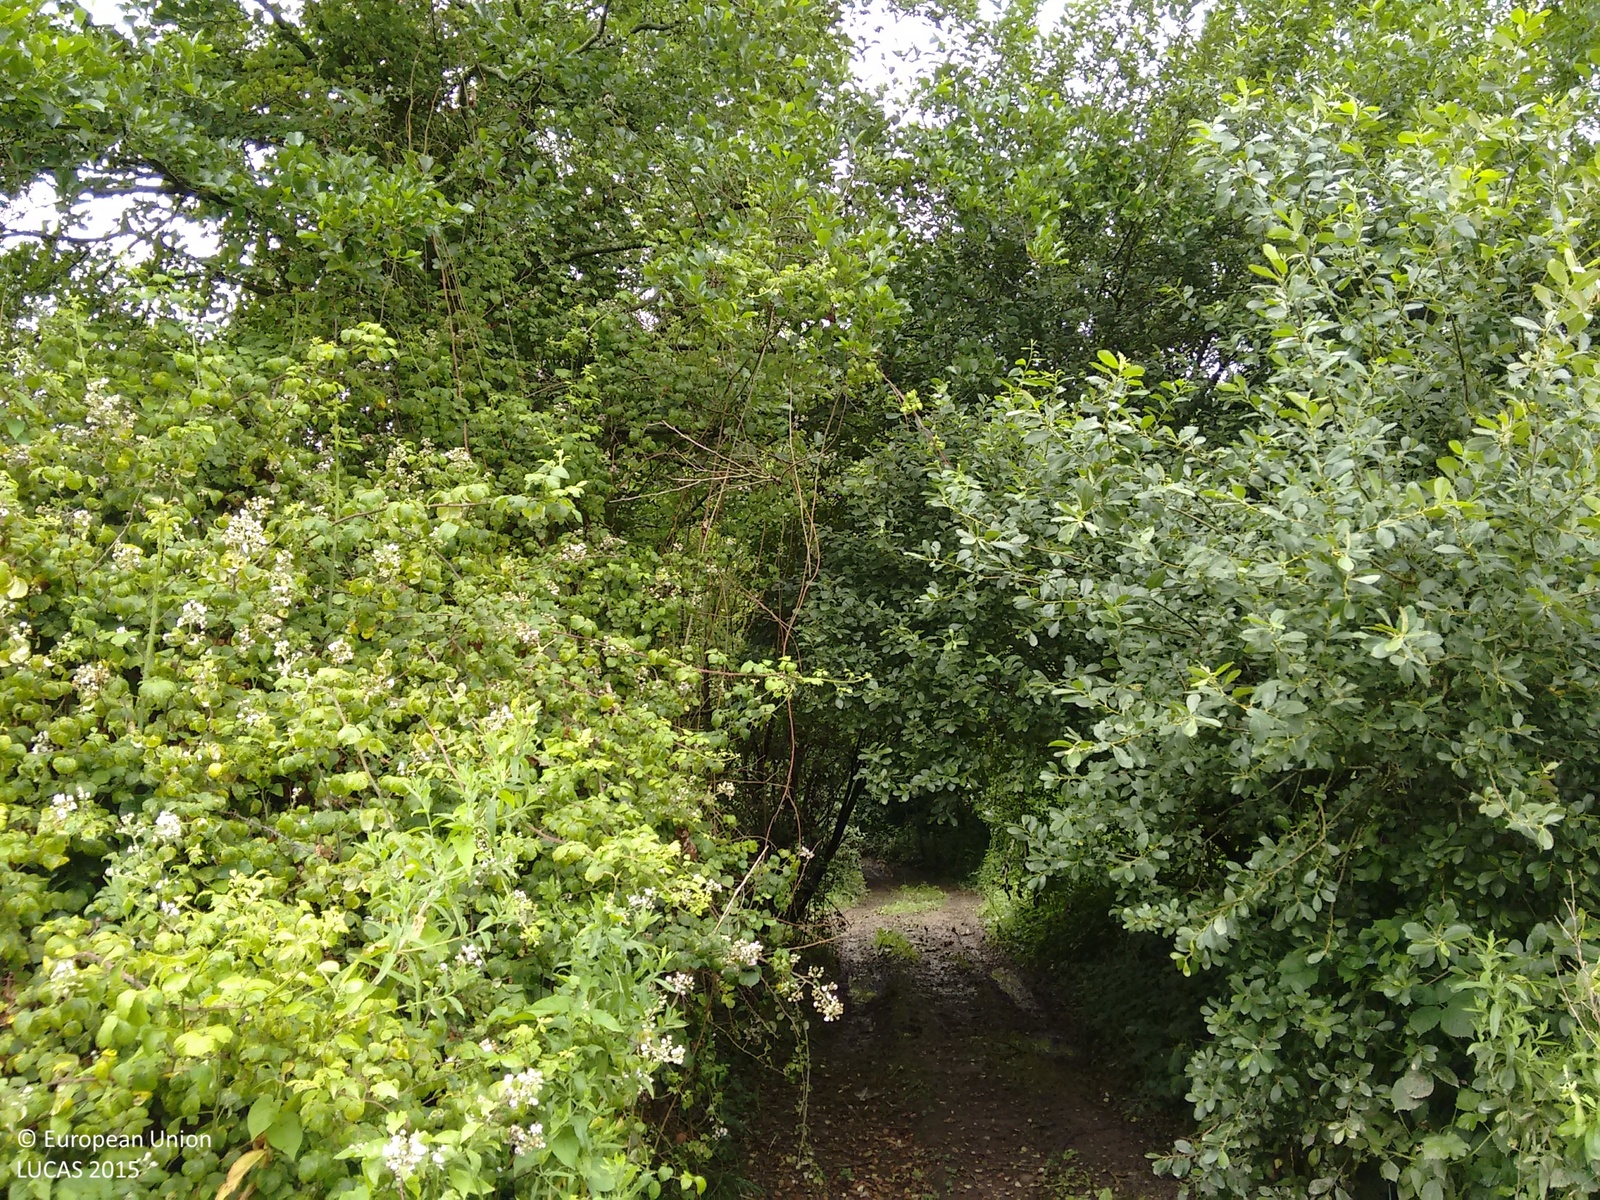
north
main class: Shrubland
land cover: Shrubland with sparse tree cover
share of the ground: > 75 %
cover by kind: shrubs 95 %, broadleaved forest trees 5 %
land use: Semi-natural and natural areas not in use
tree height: < 5 m
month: July
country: GB
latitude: 51.5182
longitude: -3.5896
